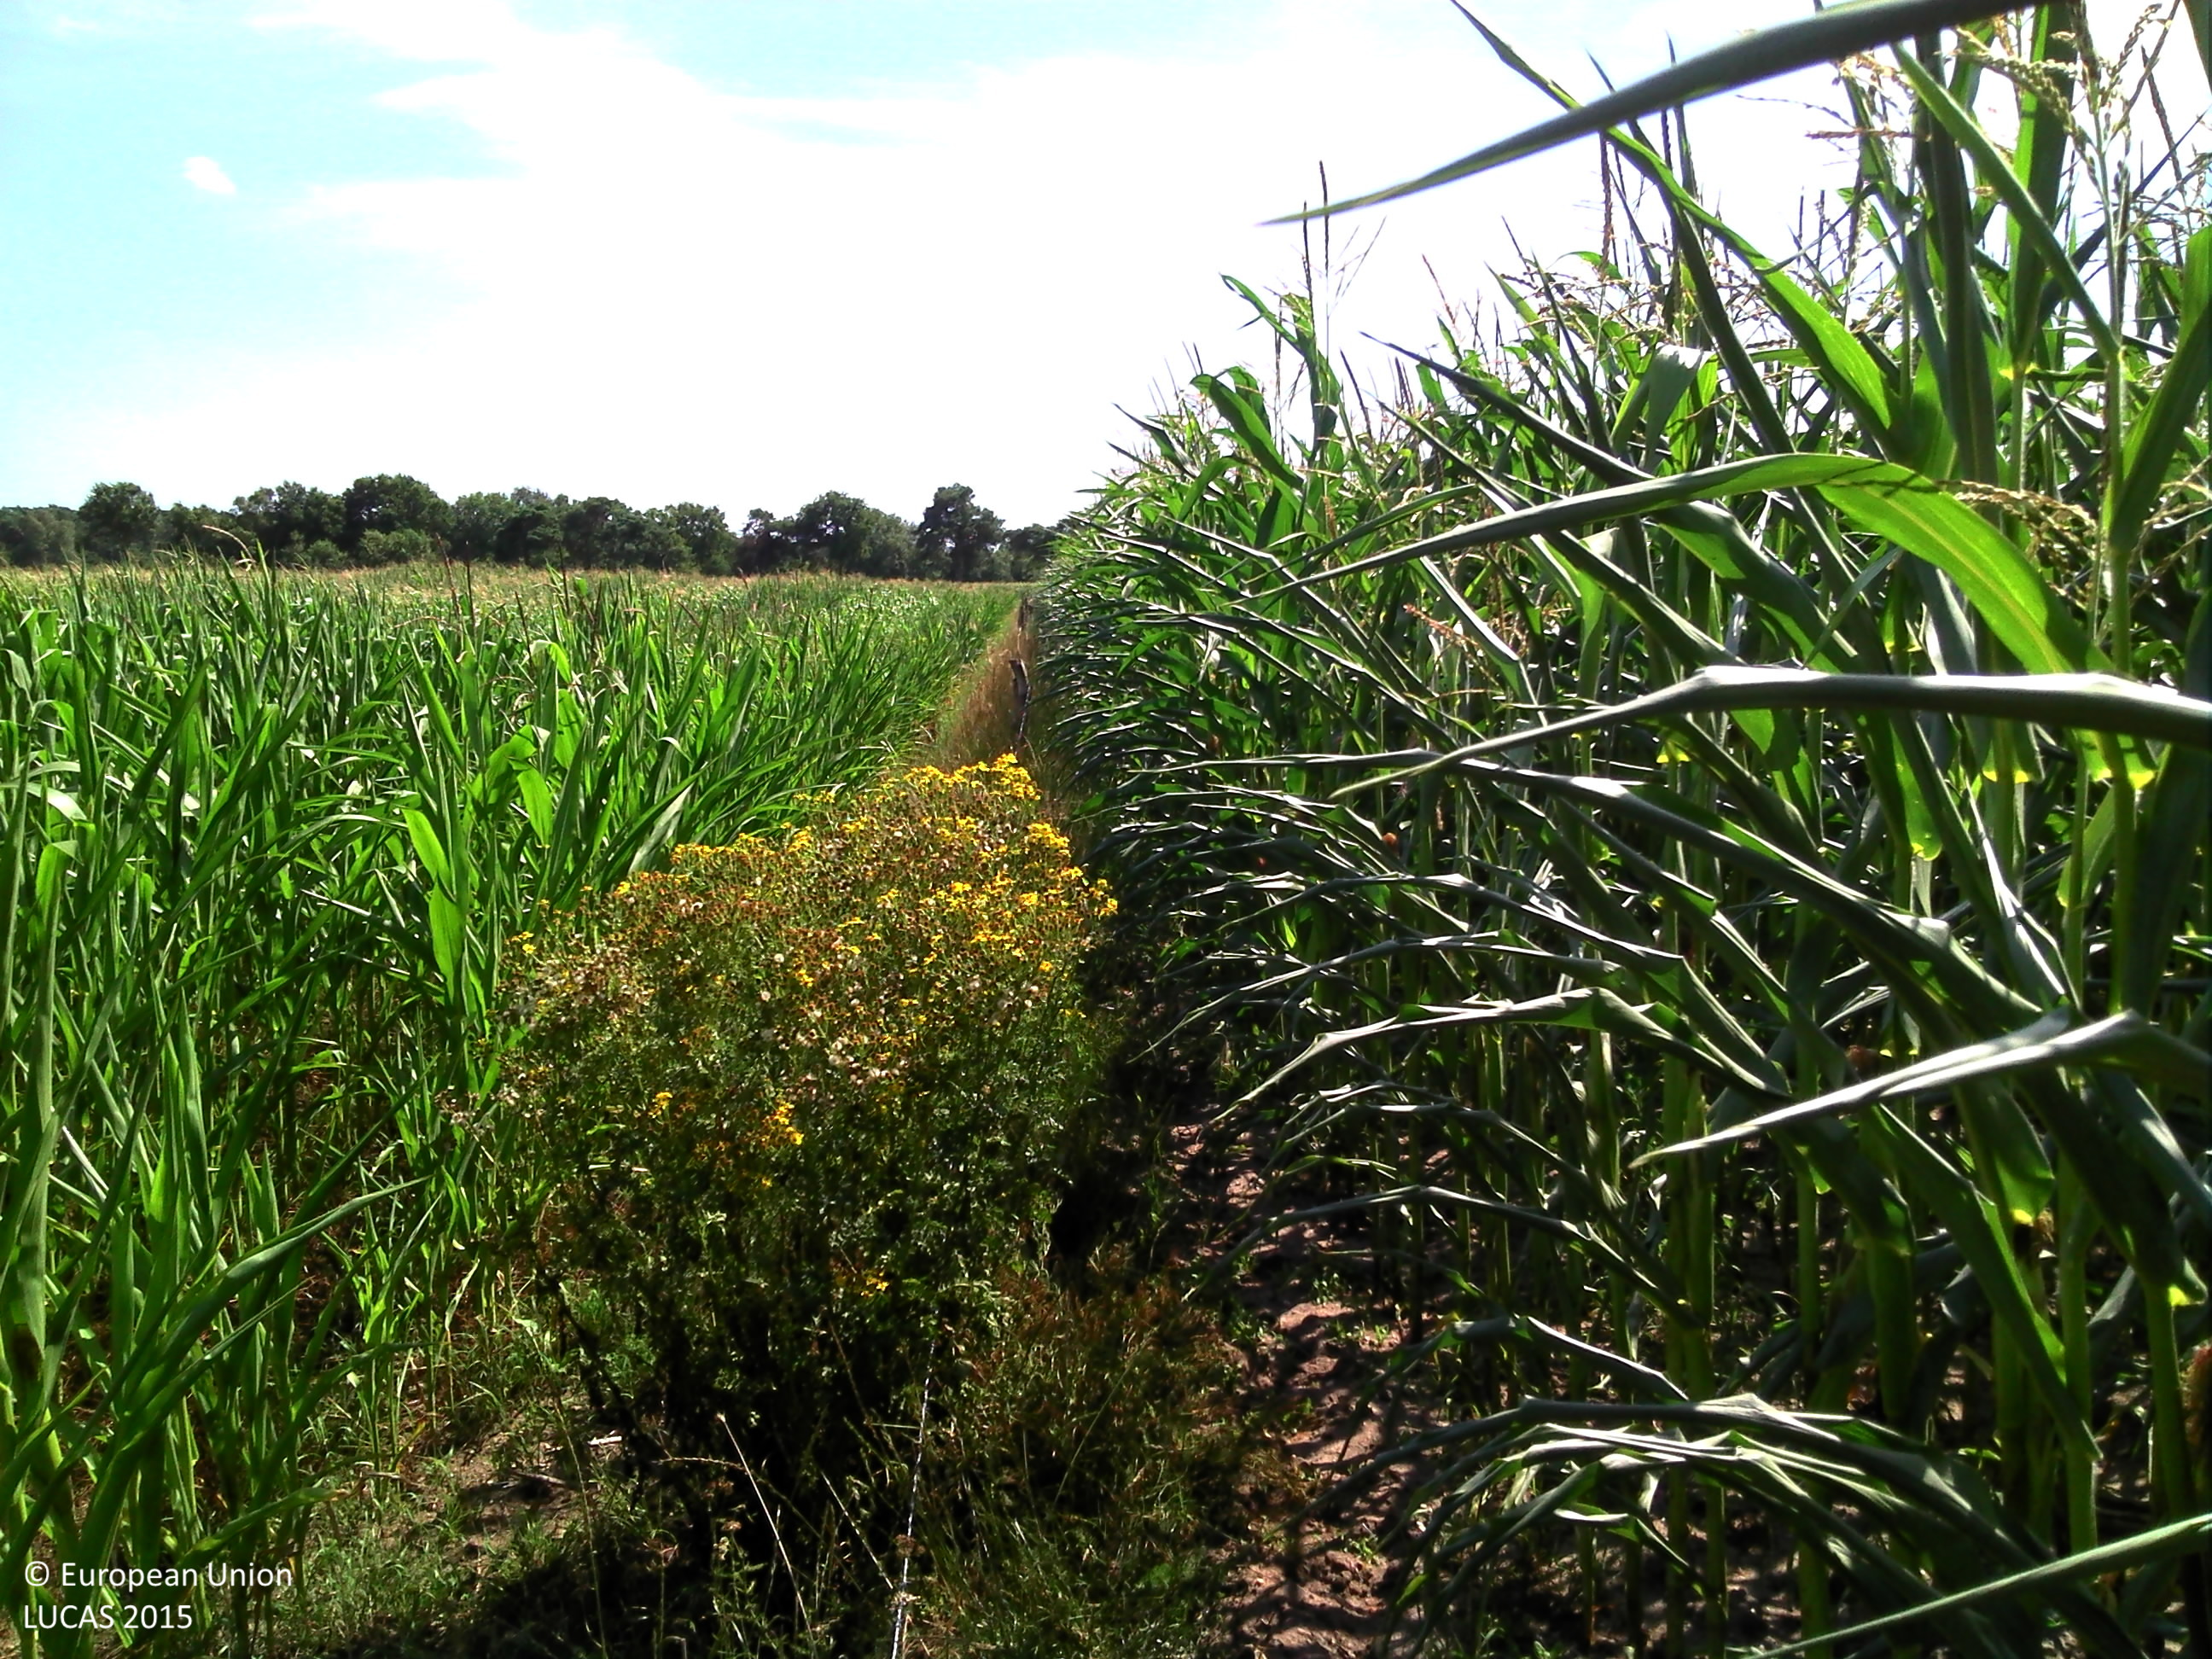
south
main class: Cropland
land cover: Maize
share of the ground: > 75 %
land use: Agriculture (excluding fallow land and kitchen gardens)
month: August
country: BE
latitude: 51.1756
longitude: 5.4924
